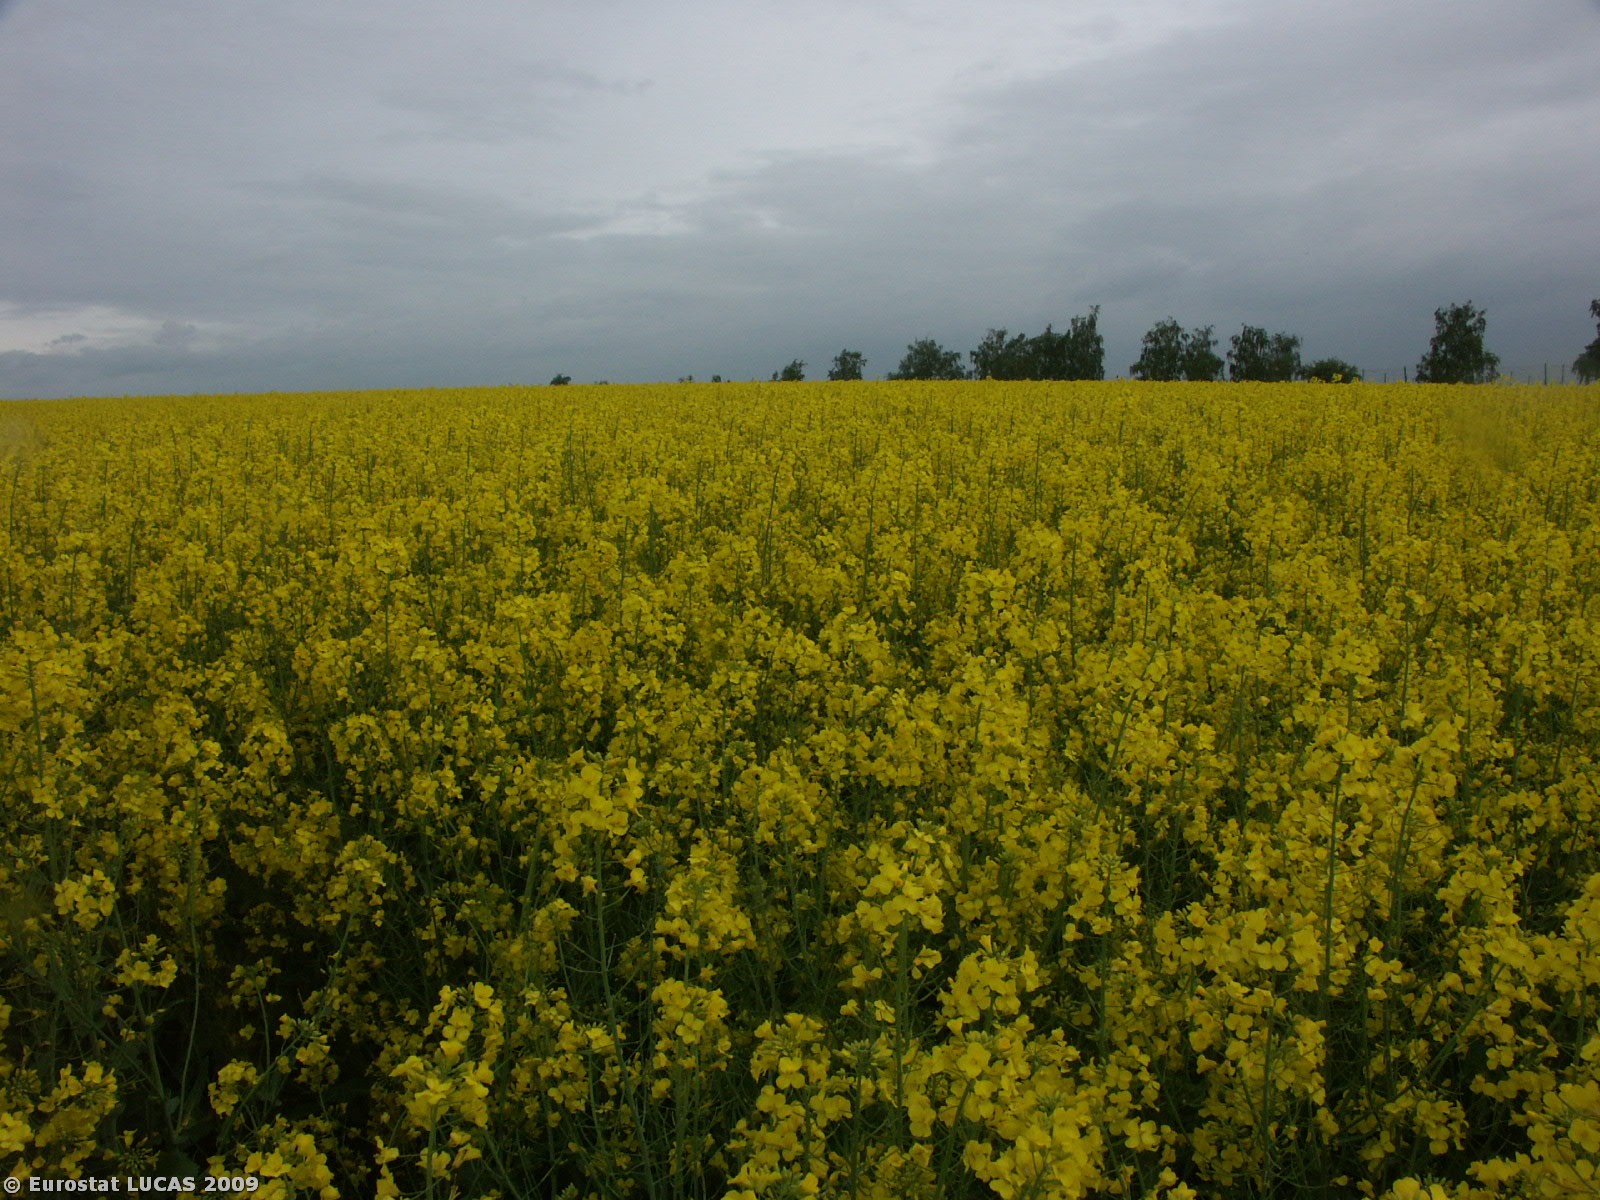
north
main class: Cropland
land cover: Rape and turnip rape
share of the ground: > 75 %
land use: Agriculture (excluding fallow land and kitchen gardens)
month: May
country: CZ
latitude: 49.5602
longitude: 17.1856
